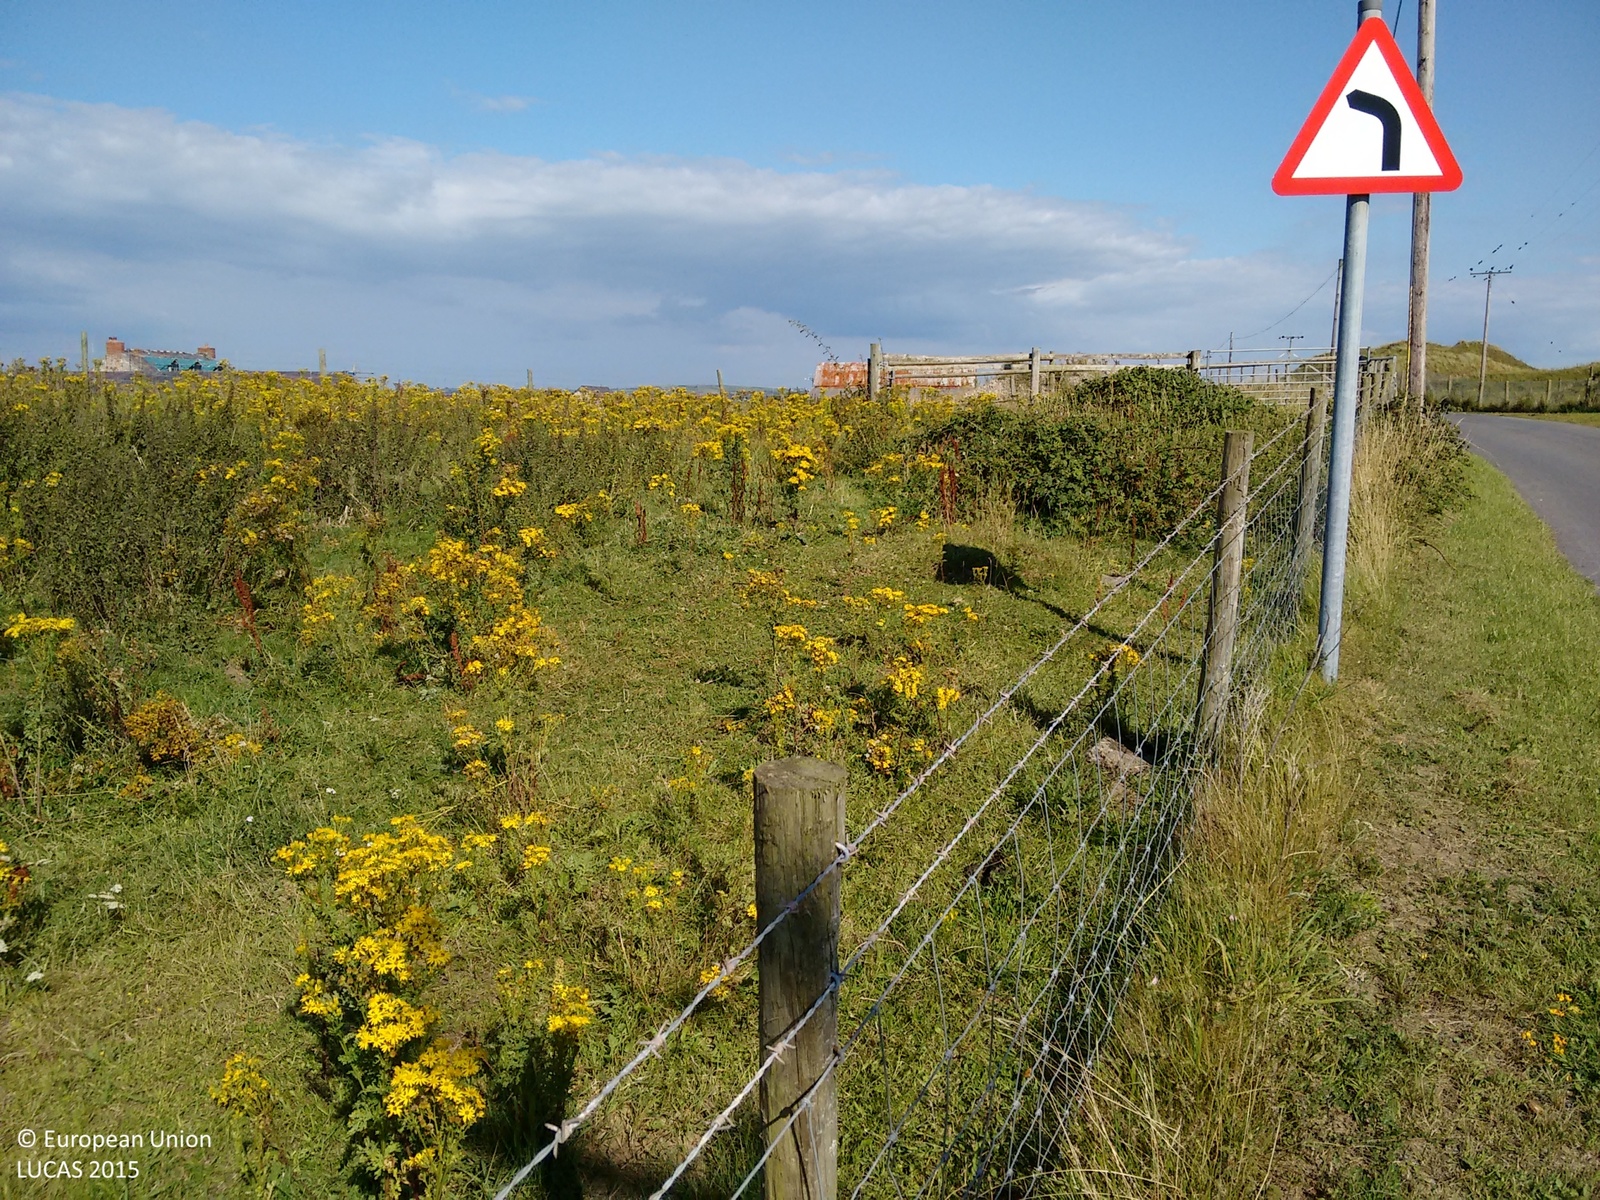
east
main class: Grassland
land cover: Grassland without tree/shrub cover
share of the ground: > 75 %
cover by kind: herbaceous plants 100 %
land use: Agriculture (excluding fallow land and kitchen gardens)
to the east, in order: Grassland without tree/shrub cover; Fences; Grassland without tree/shrub cover; Artificial constructions in urban areas; Grassland without tree/shrub cover; Tracks; Electric lines; Grassland without tree/shrub cover; Fences; Grassland without tree/shrub cover; Fences; Grass margins; Paved roads, cycling and walking lanes; Grass margins; Fences; Grassland without tree/shrub cover; Electric lines; Grassland without tree/shrub cover
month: August
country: GB
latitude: 51.7420
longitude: -4.4567
